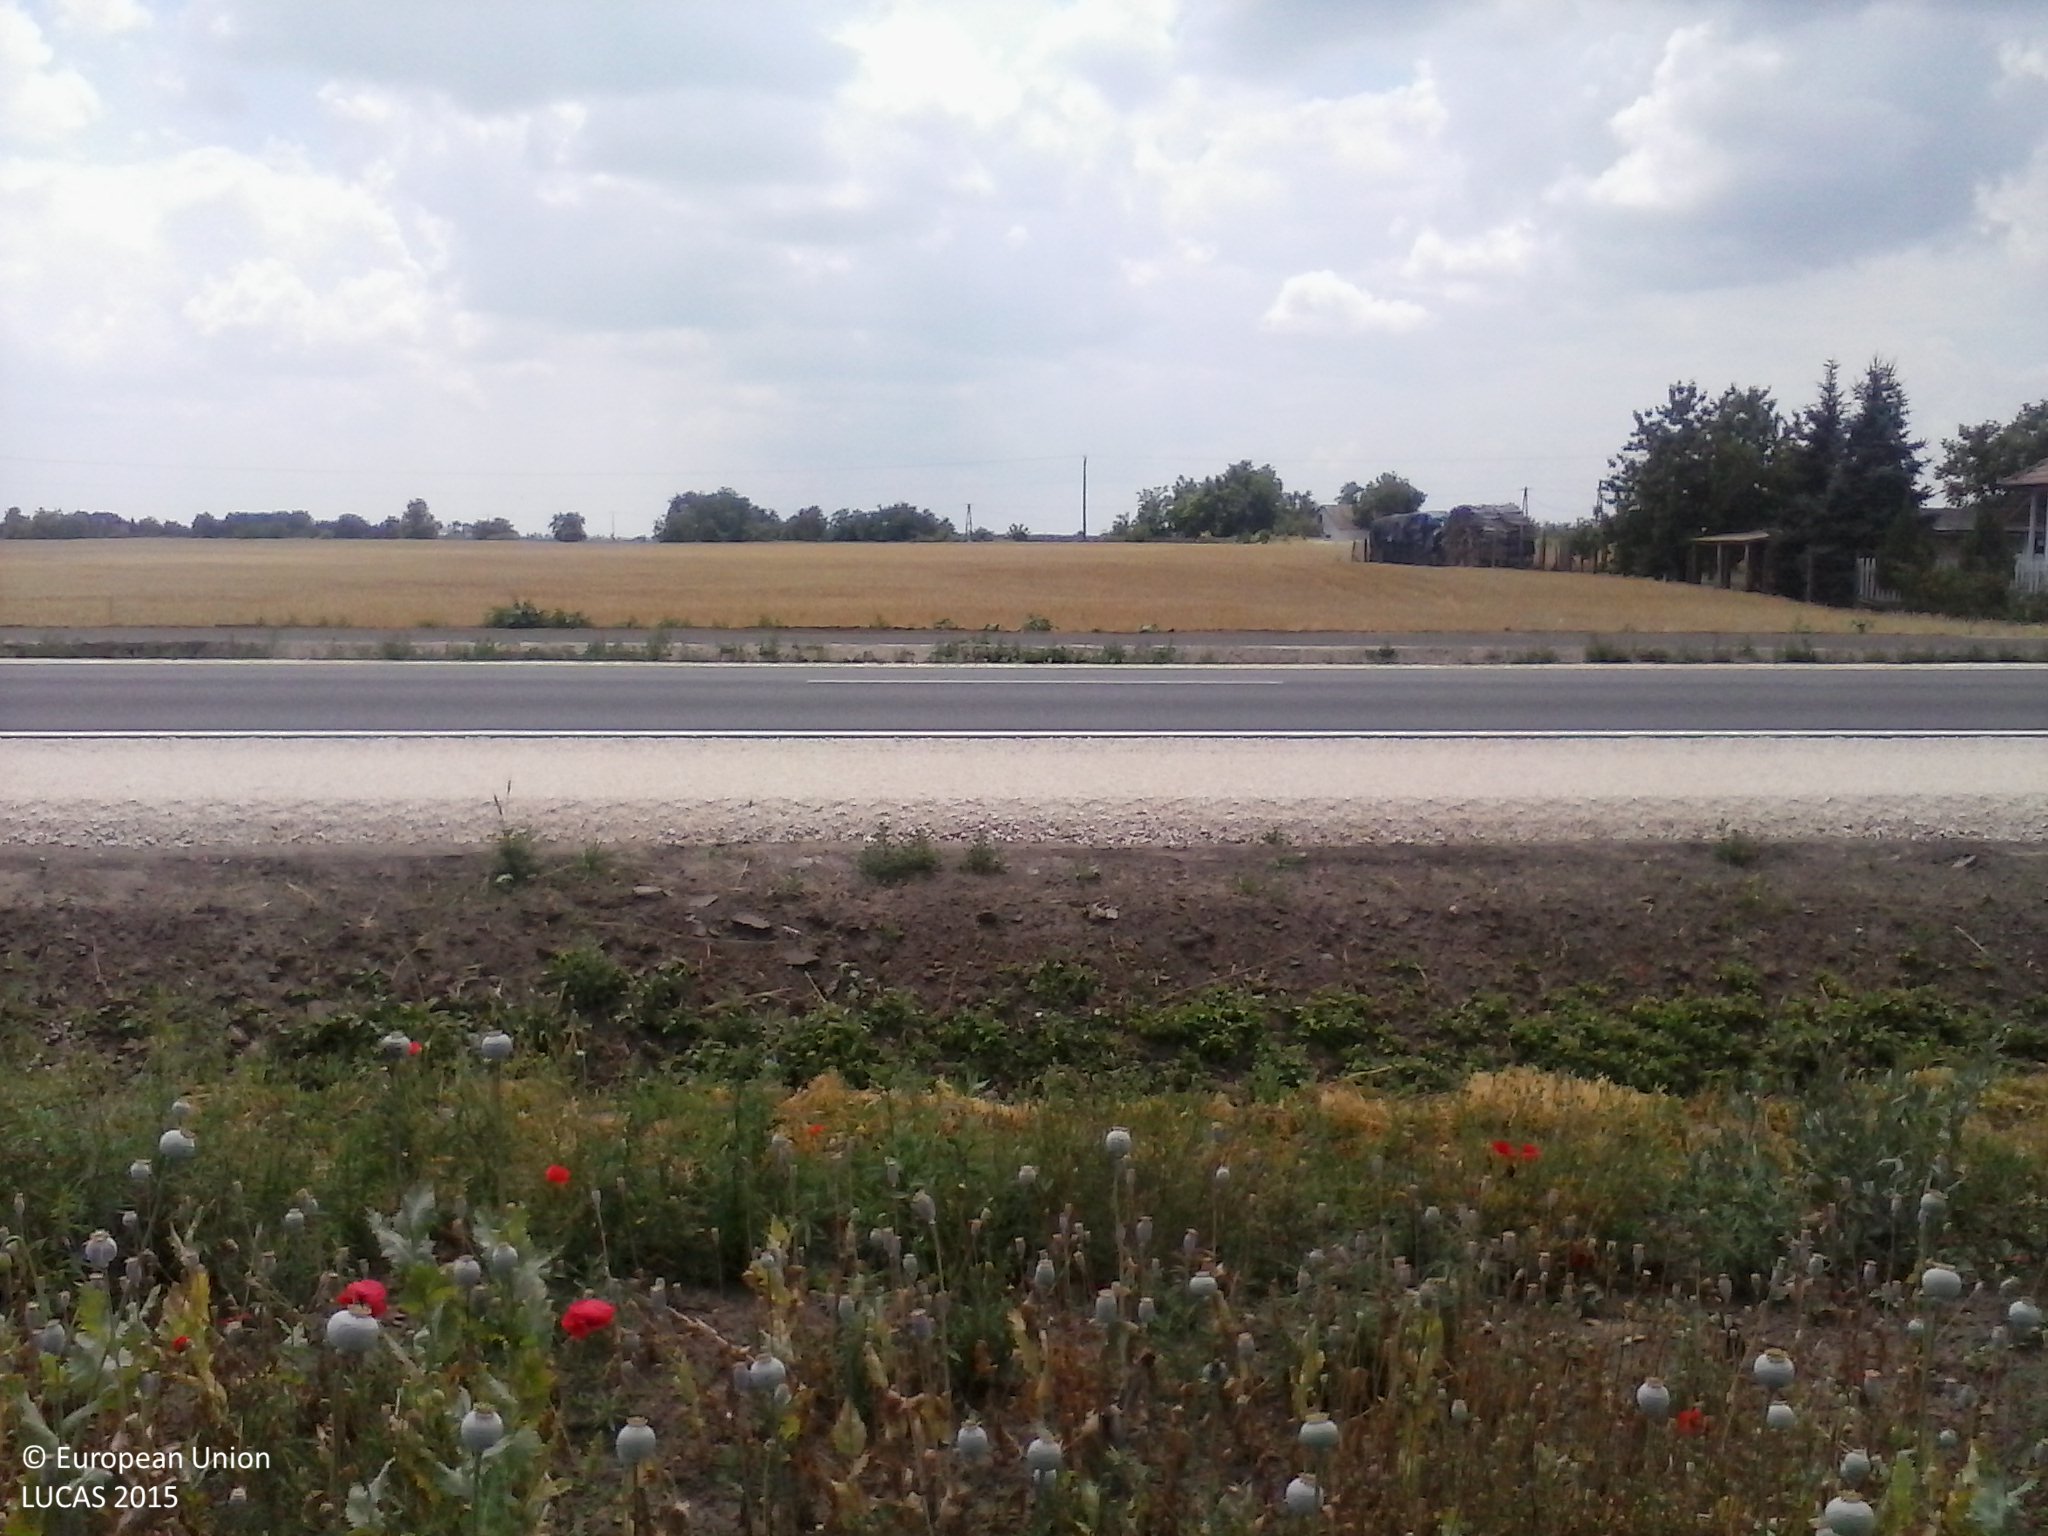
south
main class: Cropland
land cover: Other fibre and oleaginous crops
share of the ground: > 75 %
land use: Agriculture (excluding fallow land and kitchen gardens)
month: June
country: HU
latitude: 46.2718
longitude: 19.5020
